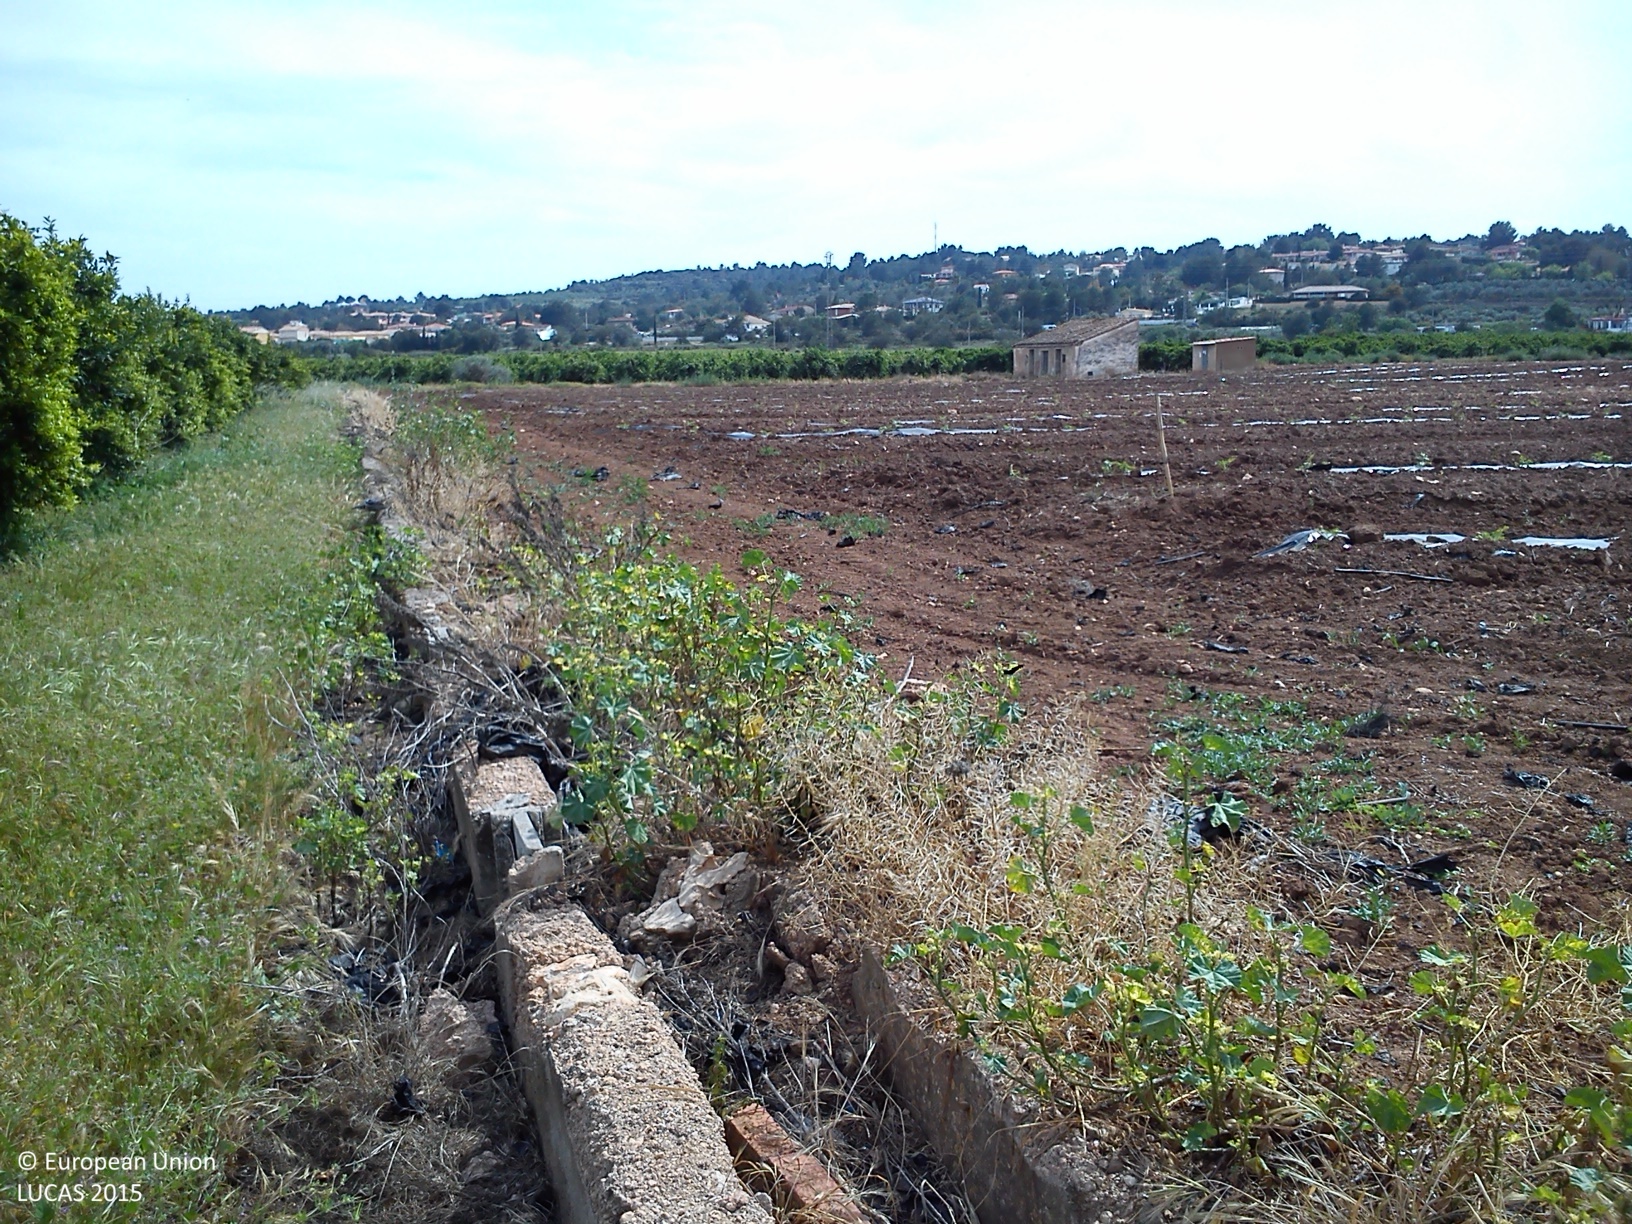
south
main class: Cropland
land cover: Oranges
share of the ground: > 75 %
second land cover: Spontaneously vegetated surfaces
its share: < 10 %
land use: Agriculture (excluding fallow land and kitchen gardens)
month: April
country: ES
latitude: 39.3946
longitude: -0.6454
